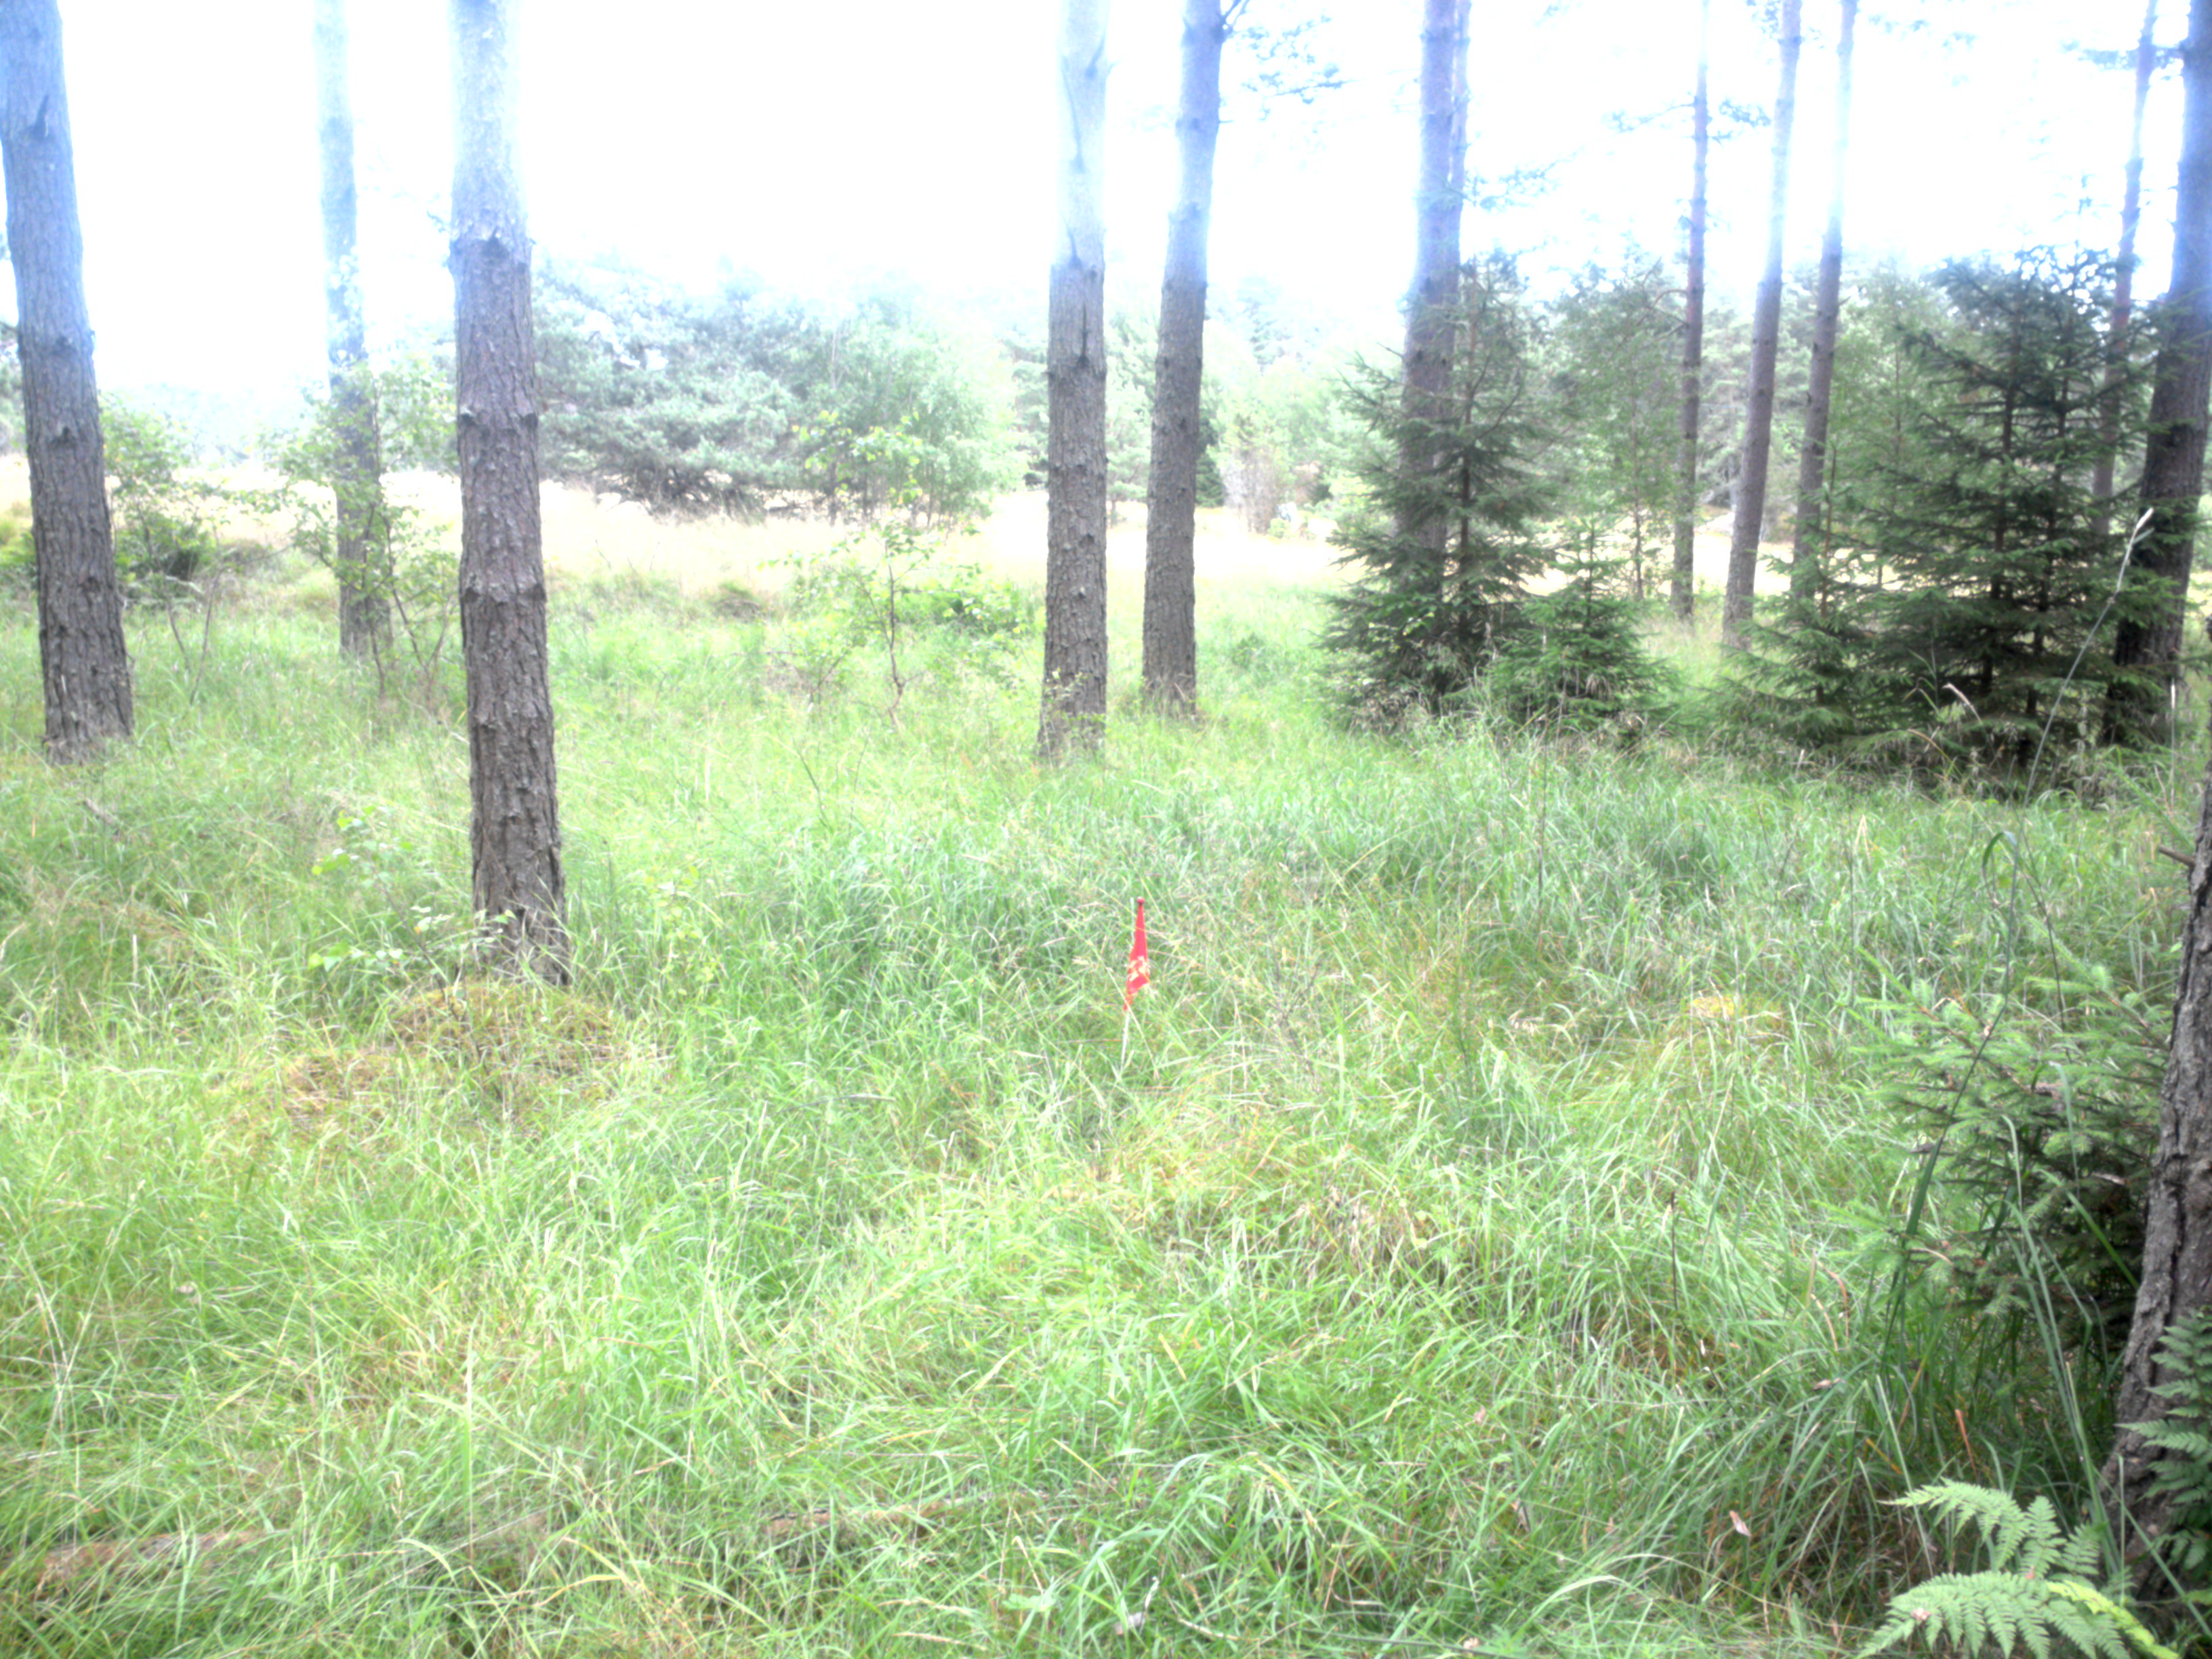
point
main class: Woodland
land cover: Pine dominated coniferous woodland
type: boreal forest
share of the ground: 50 - 75 %
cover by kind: coniferous forest trees 65 %, herbaceous plants 35 %
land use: Forestry
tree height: > 5 m
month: July
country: SE
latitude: 59.1452
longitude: 18.1988
